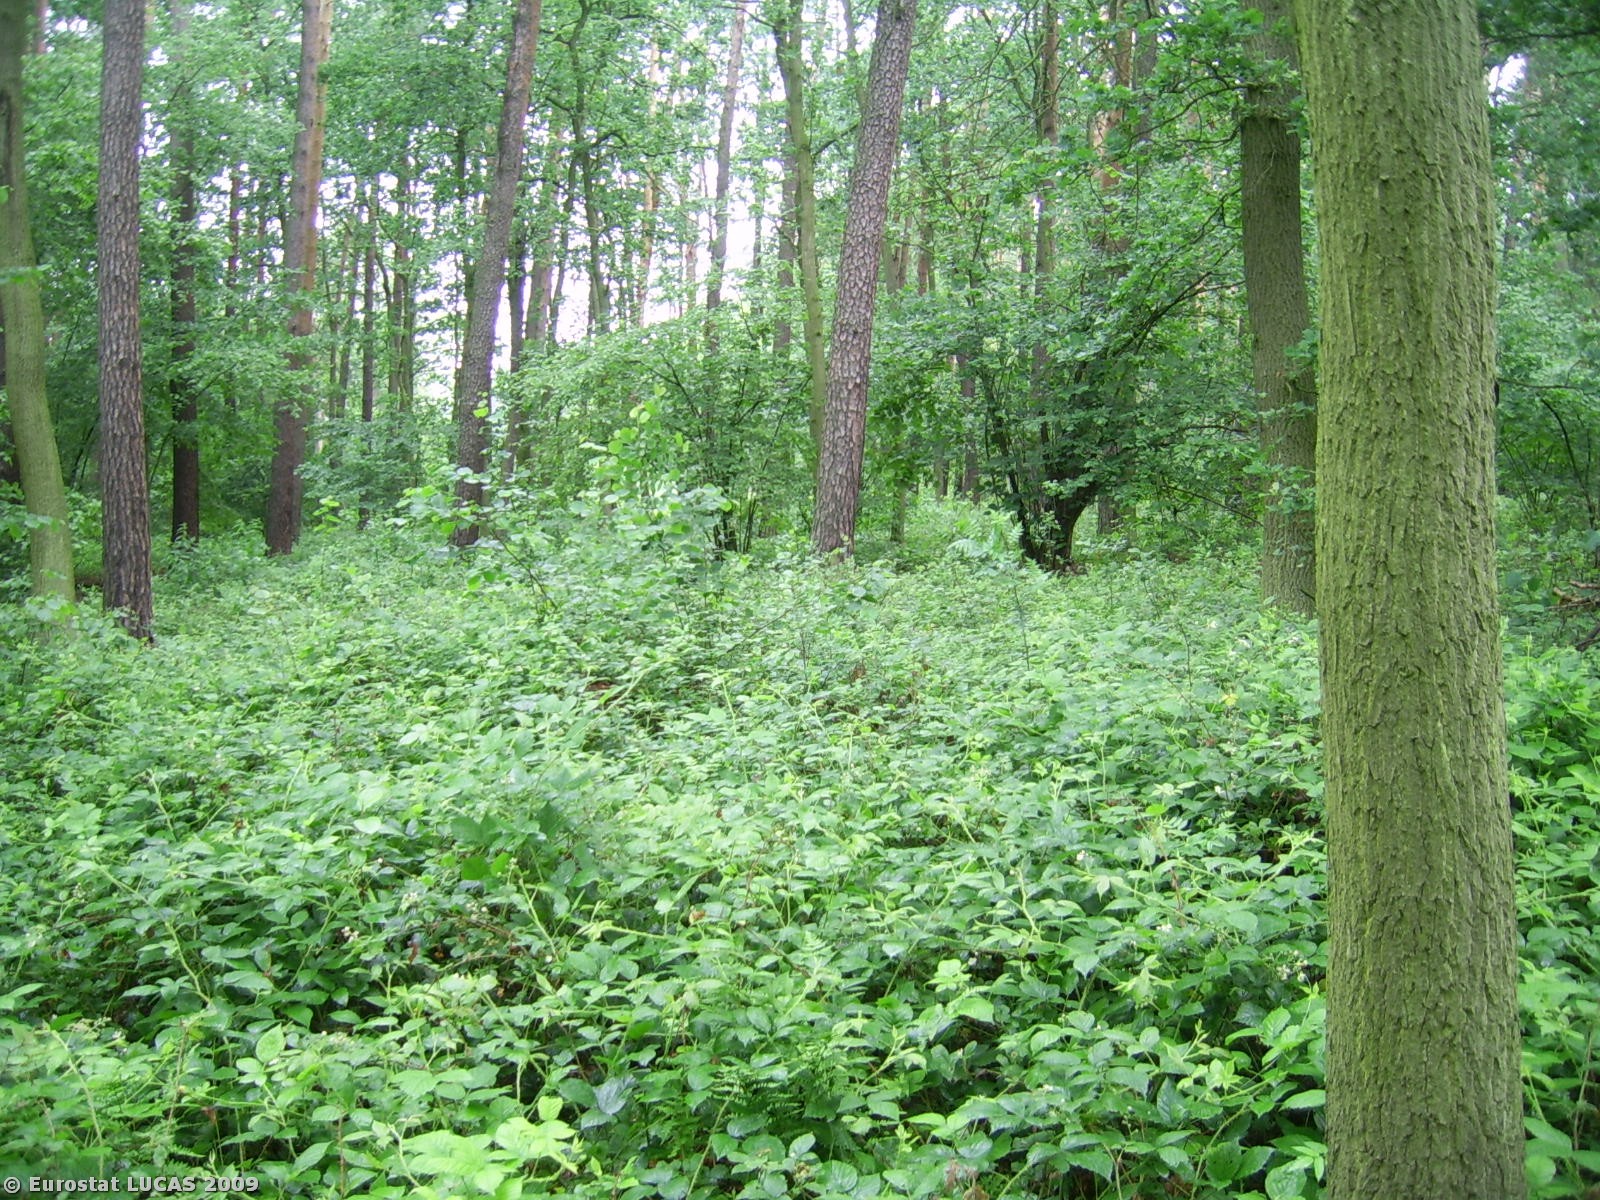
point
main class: Woodland
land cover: Mixed woodland
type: hemiboreal forest and nemoral coniferous forest and mixed broadleaved-coniferous forest
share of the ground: > 75 %
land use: Unused
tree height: > 5 m
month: June
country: PL
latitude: 51.5816
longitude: 18.0254
